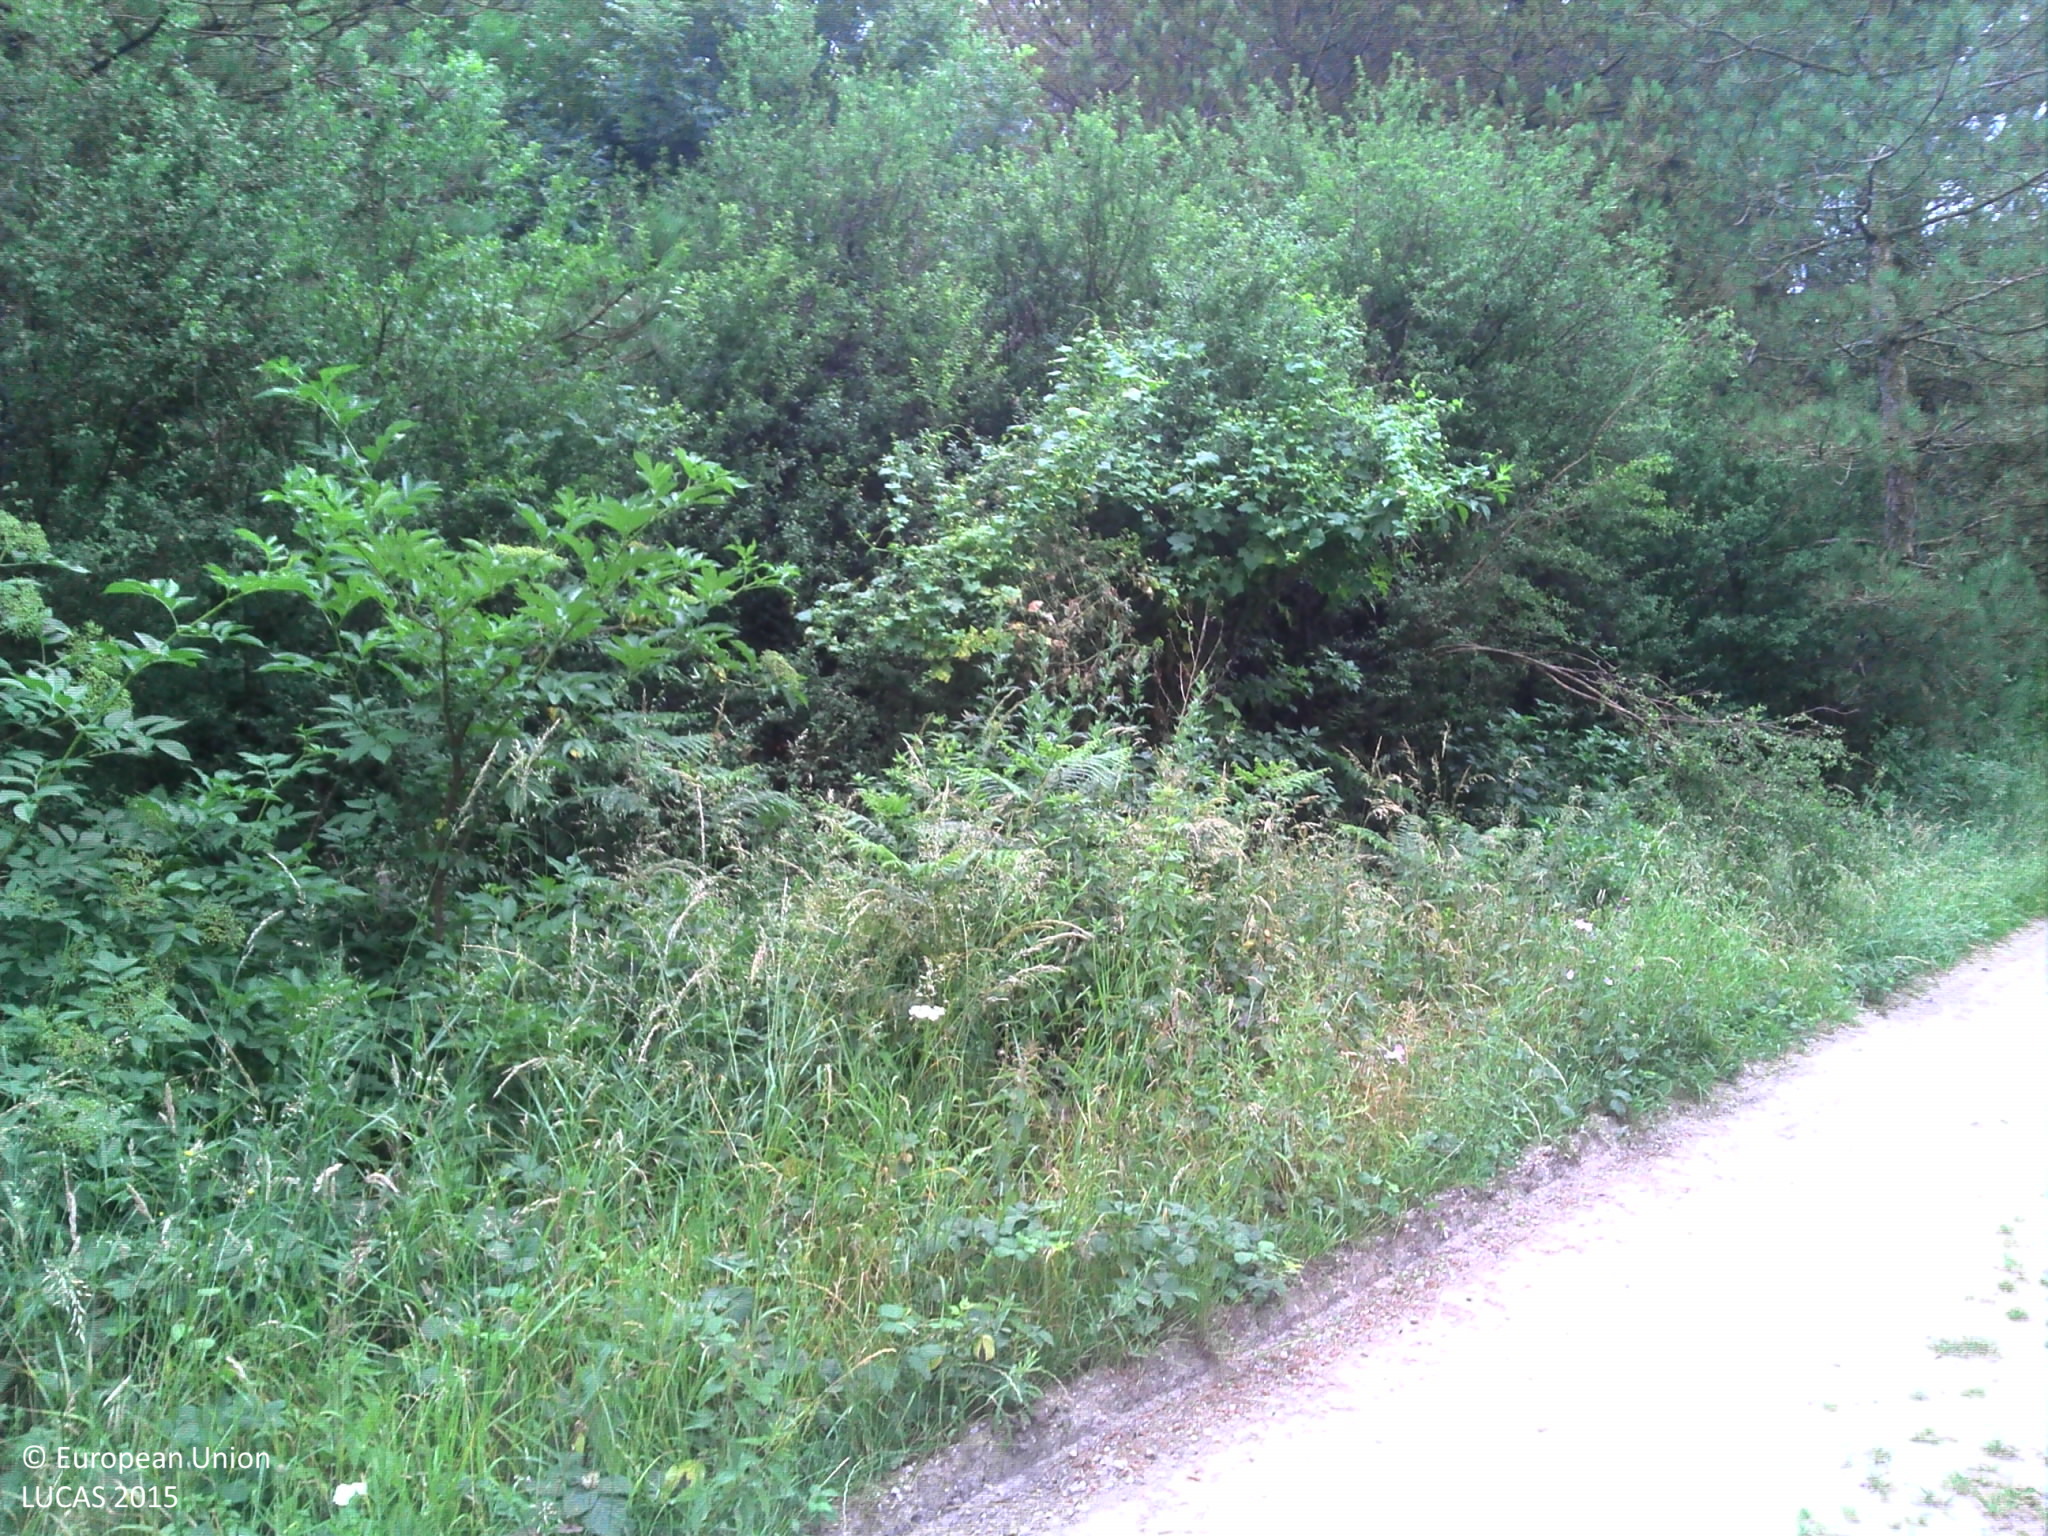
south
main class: Woodland
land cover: Pine dominated coniferous woodland
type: coniferous forest of the mediterranean region
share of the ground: > 75 %
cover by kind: coniferous forest trees 100 %
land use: Forestry
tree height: > 5 m
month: June
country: FR
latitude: 43.4103
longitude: 2.0408
